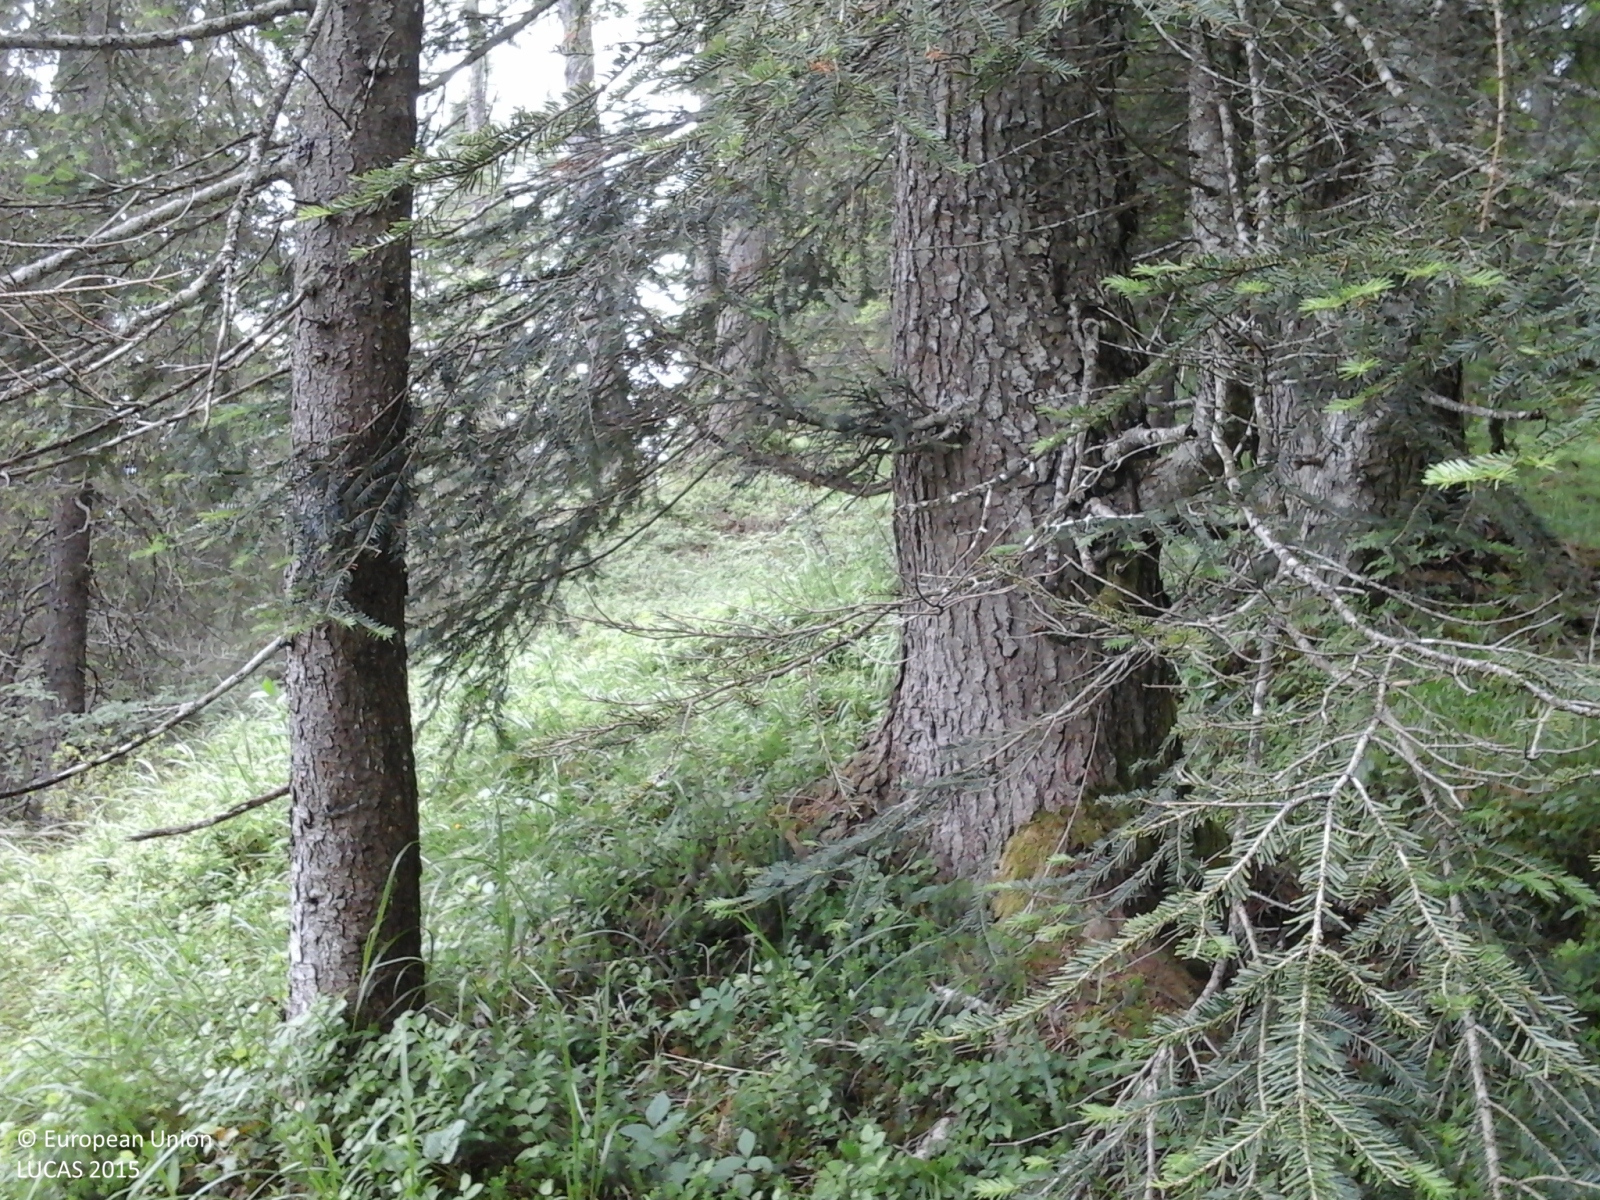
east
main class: Woodland
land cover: Spruce dominated coniferous woodland
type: alpine coniferous forest
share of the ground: > 75 %
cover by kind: coniferous forest trees 100 %
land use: Forestry
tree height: > 5 m
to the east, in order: Spruce dominated coniferous woodland
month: June
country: IT
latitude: 45.9615
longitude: 11.5591
